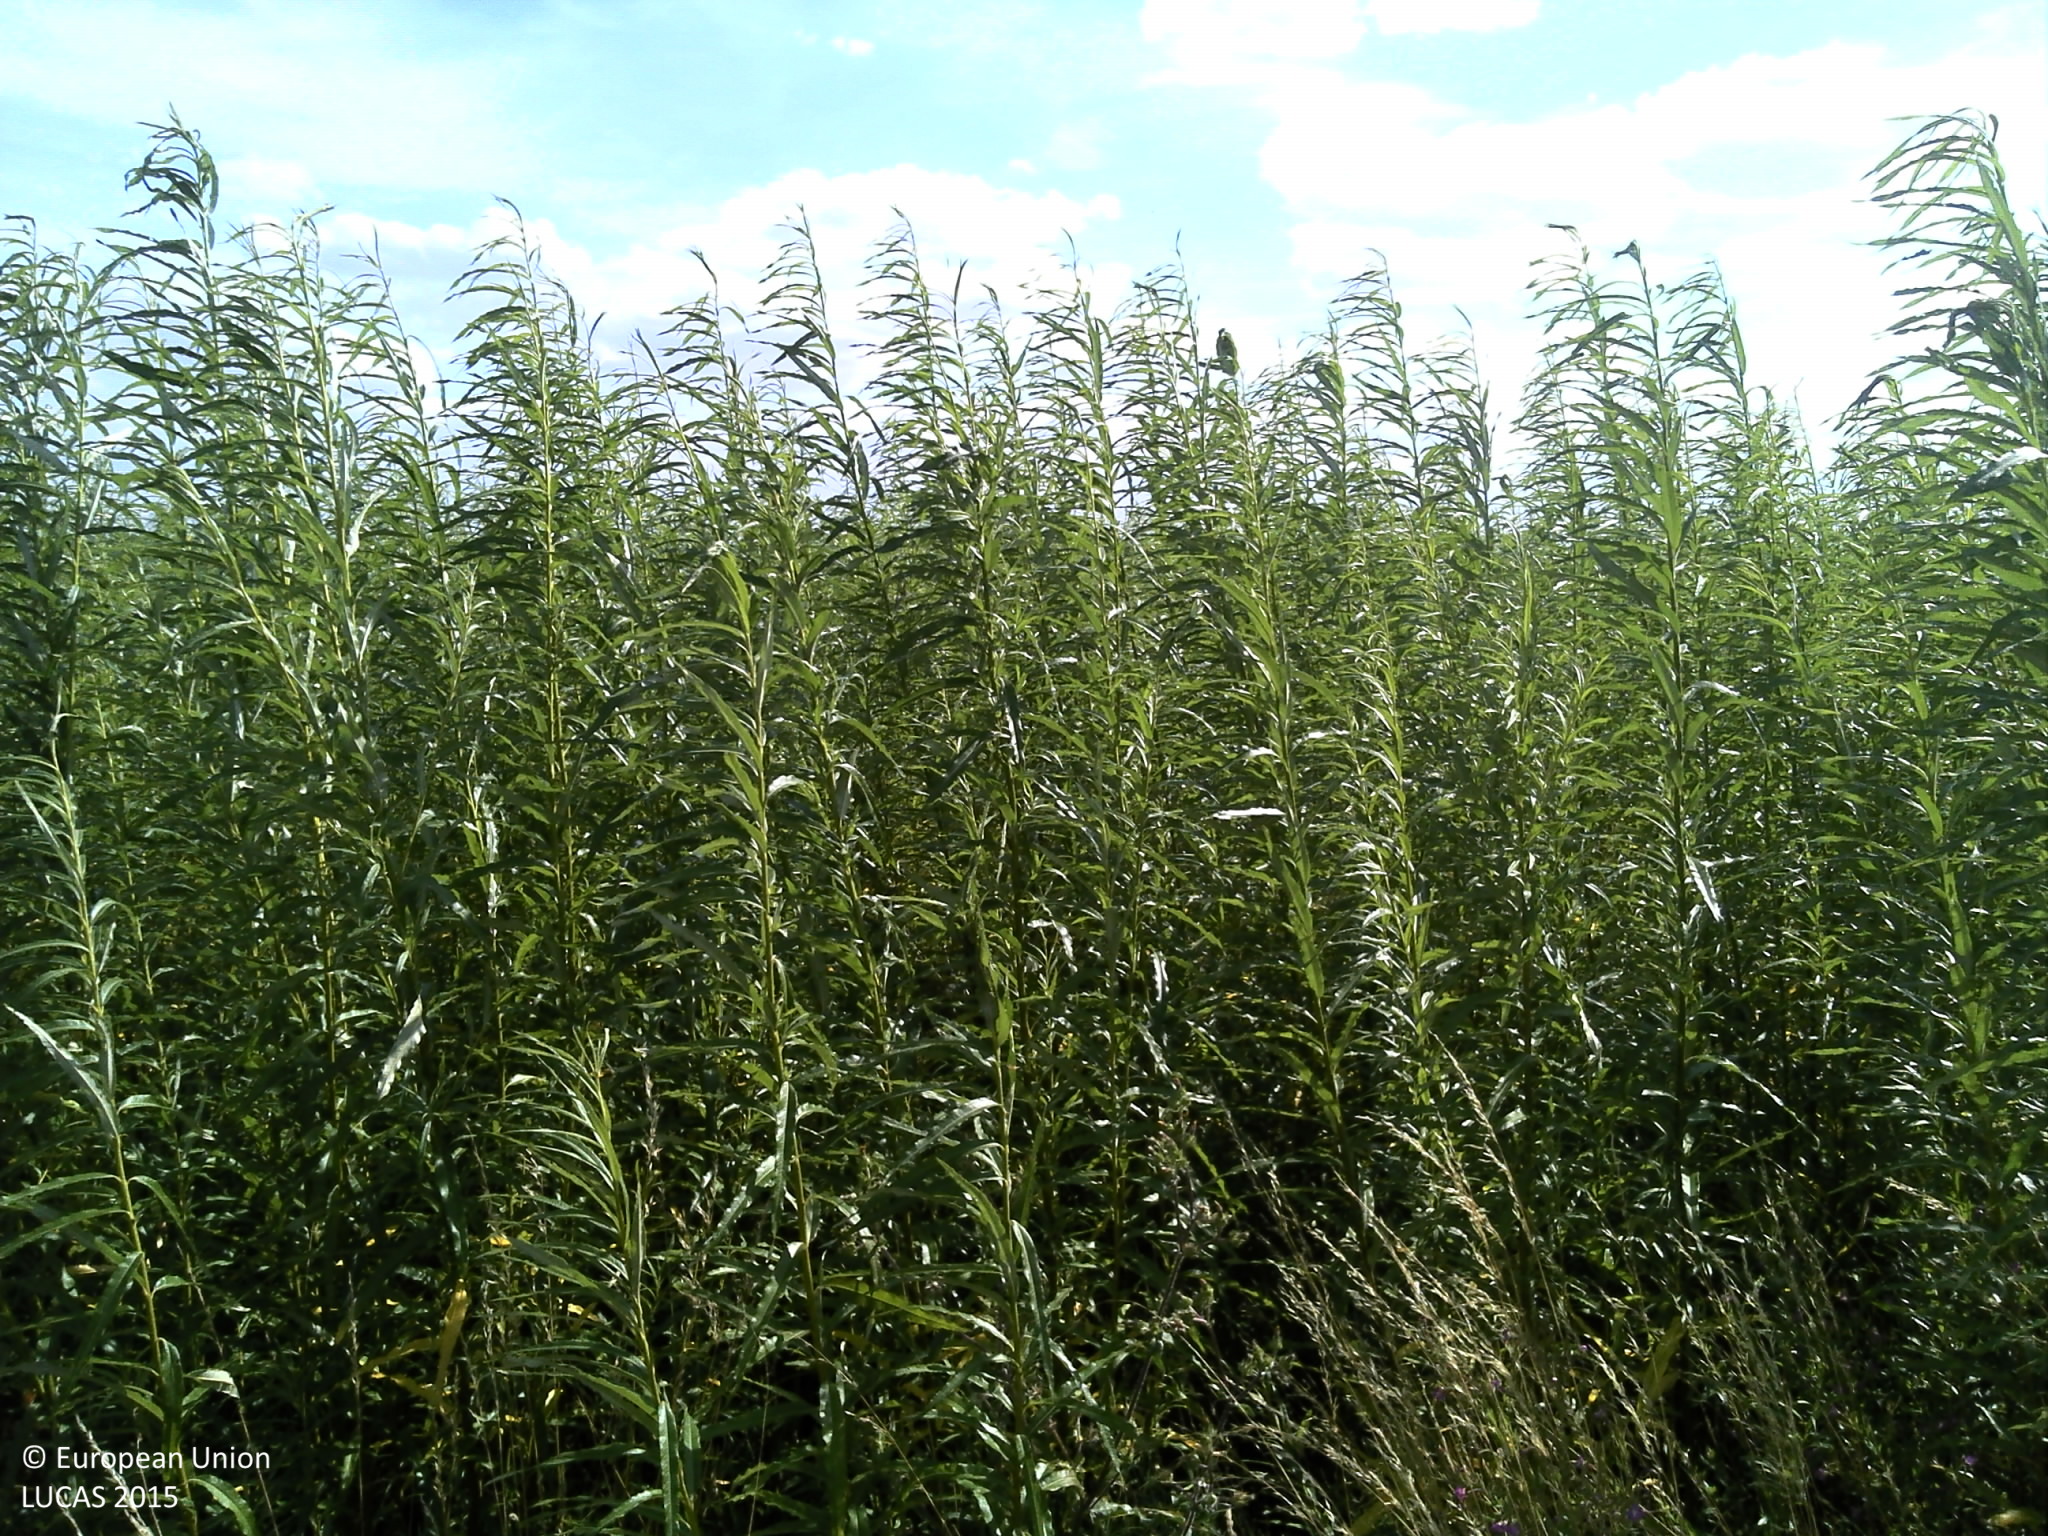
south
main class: Cropland
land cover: Permanent industrial crops
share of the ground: > 75 %
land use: Agriculture (excluding fallow land and kitchen gardens)
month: July
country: FR
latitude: 49.5114
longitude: 4.5132
